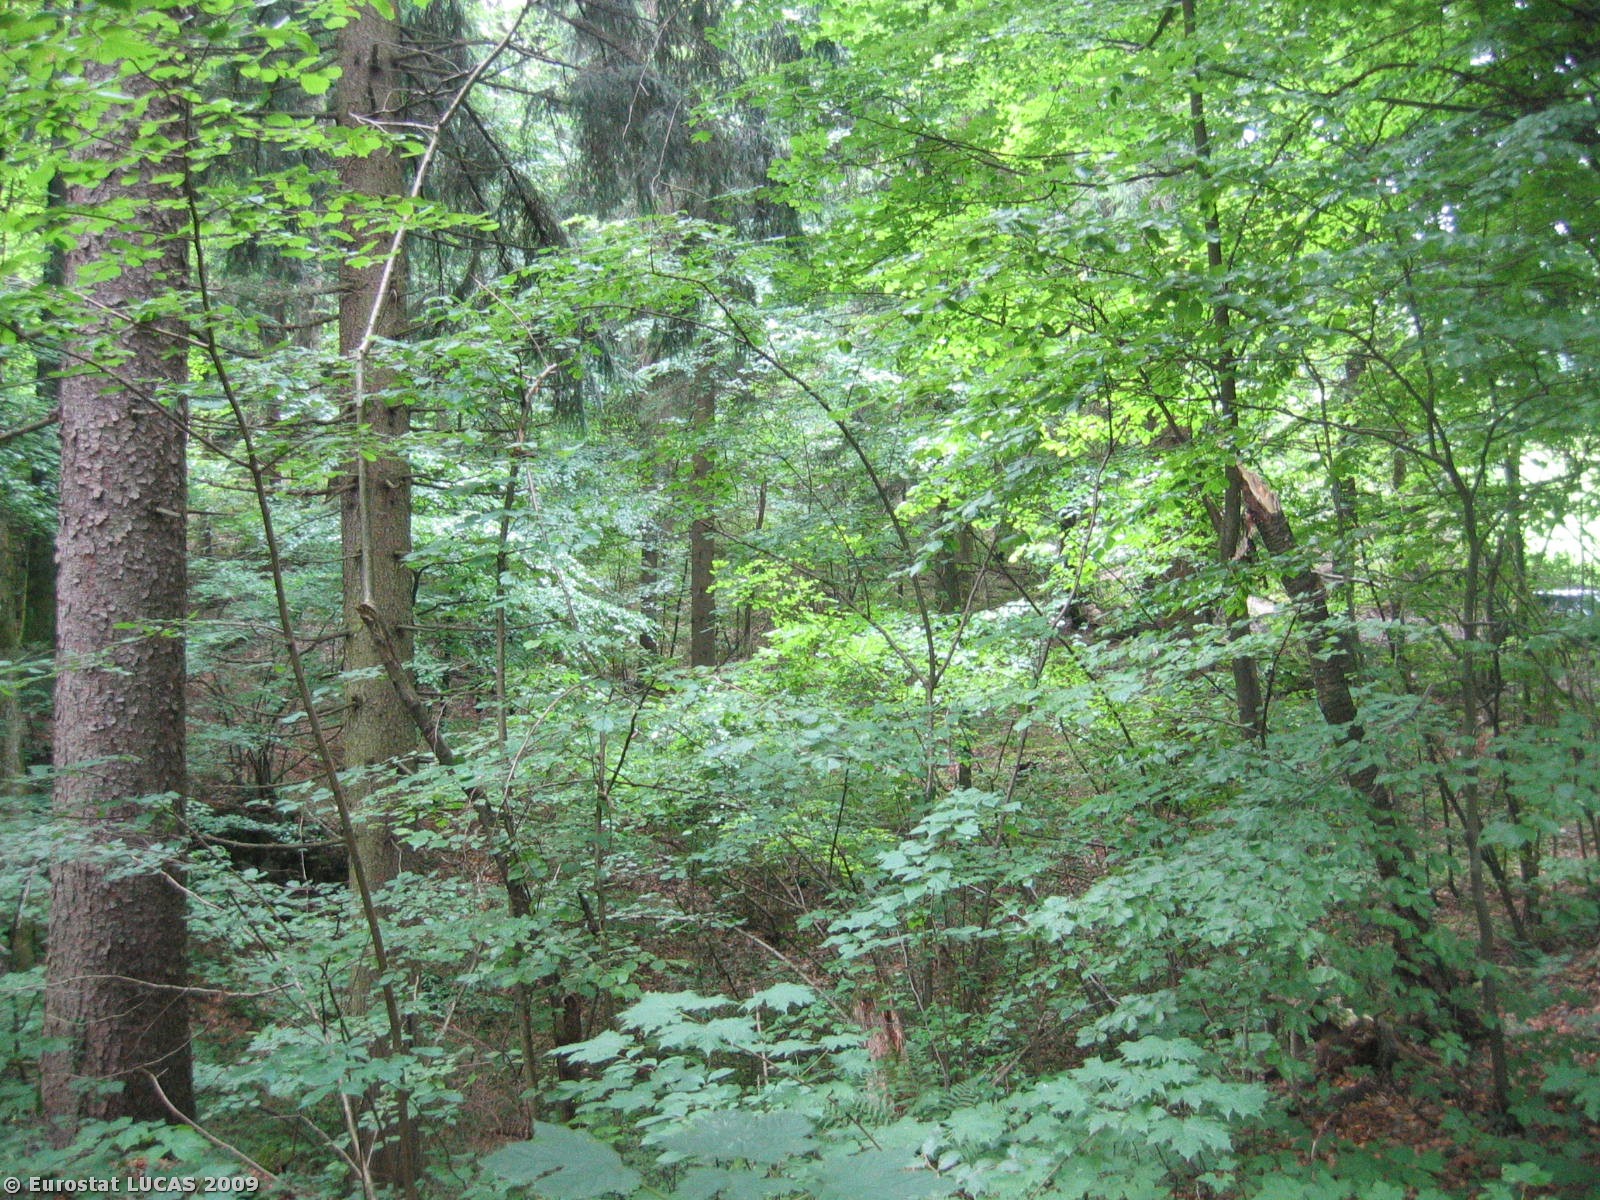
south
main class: Woodland
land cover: Mixed woodland
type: beech forest
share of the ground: > 75 %
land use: Forestry
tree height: > 5 m
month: July
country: SI
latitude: 45.9975
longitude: 14.2184
